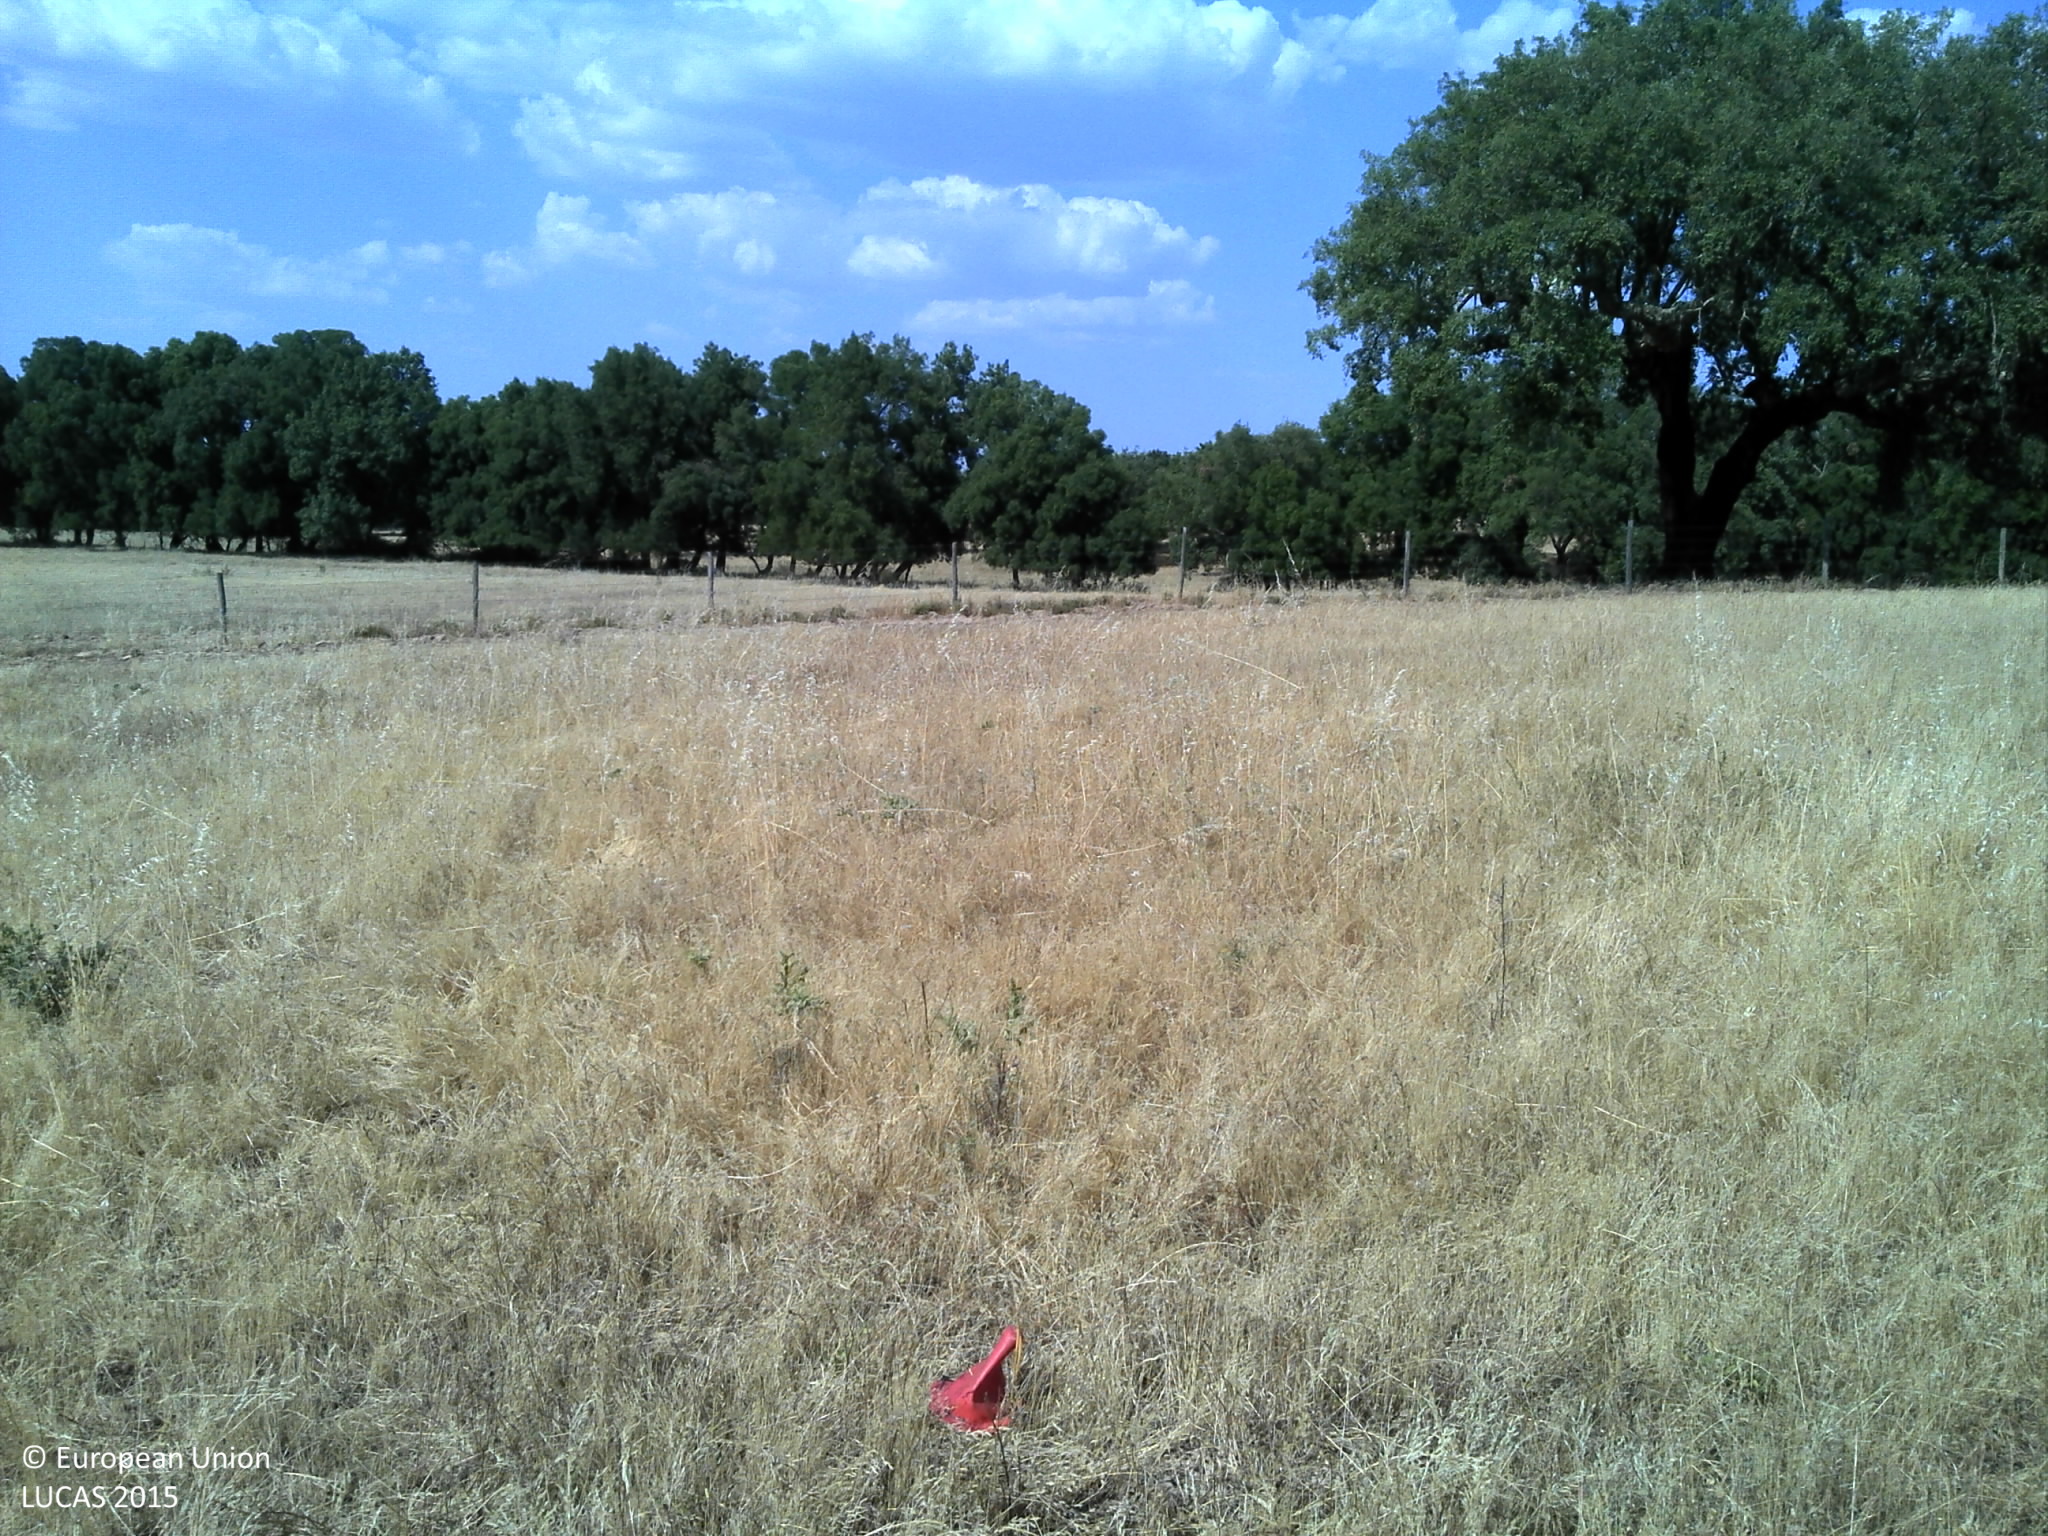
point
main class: Grassland
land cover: Grassland without tree/shrub cover
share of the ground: > 75 %
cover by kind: herbaceous plants 90 %, unconsolidated bare surface 10 %
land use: Agriculture (excluding fallow land and kitchen gardens)
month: June
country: PT
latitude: 38.7029
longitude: -7.8758
